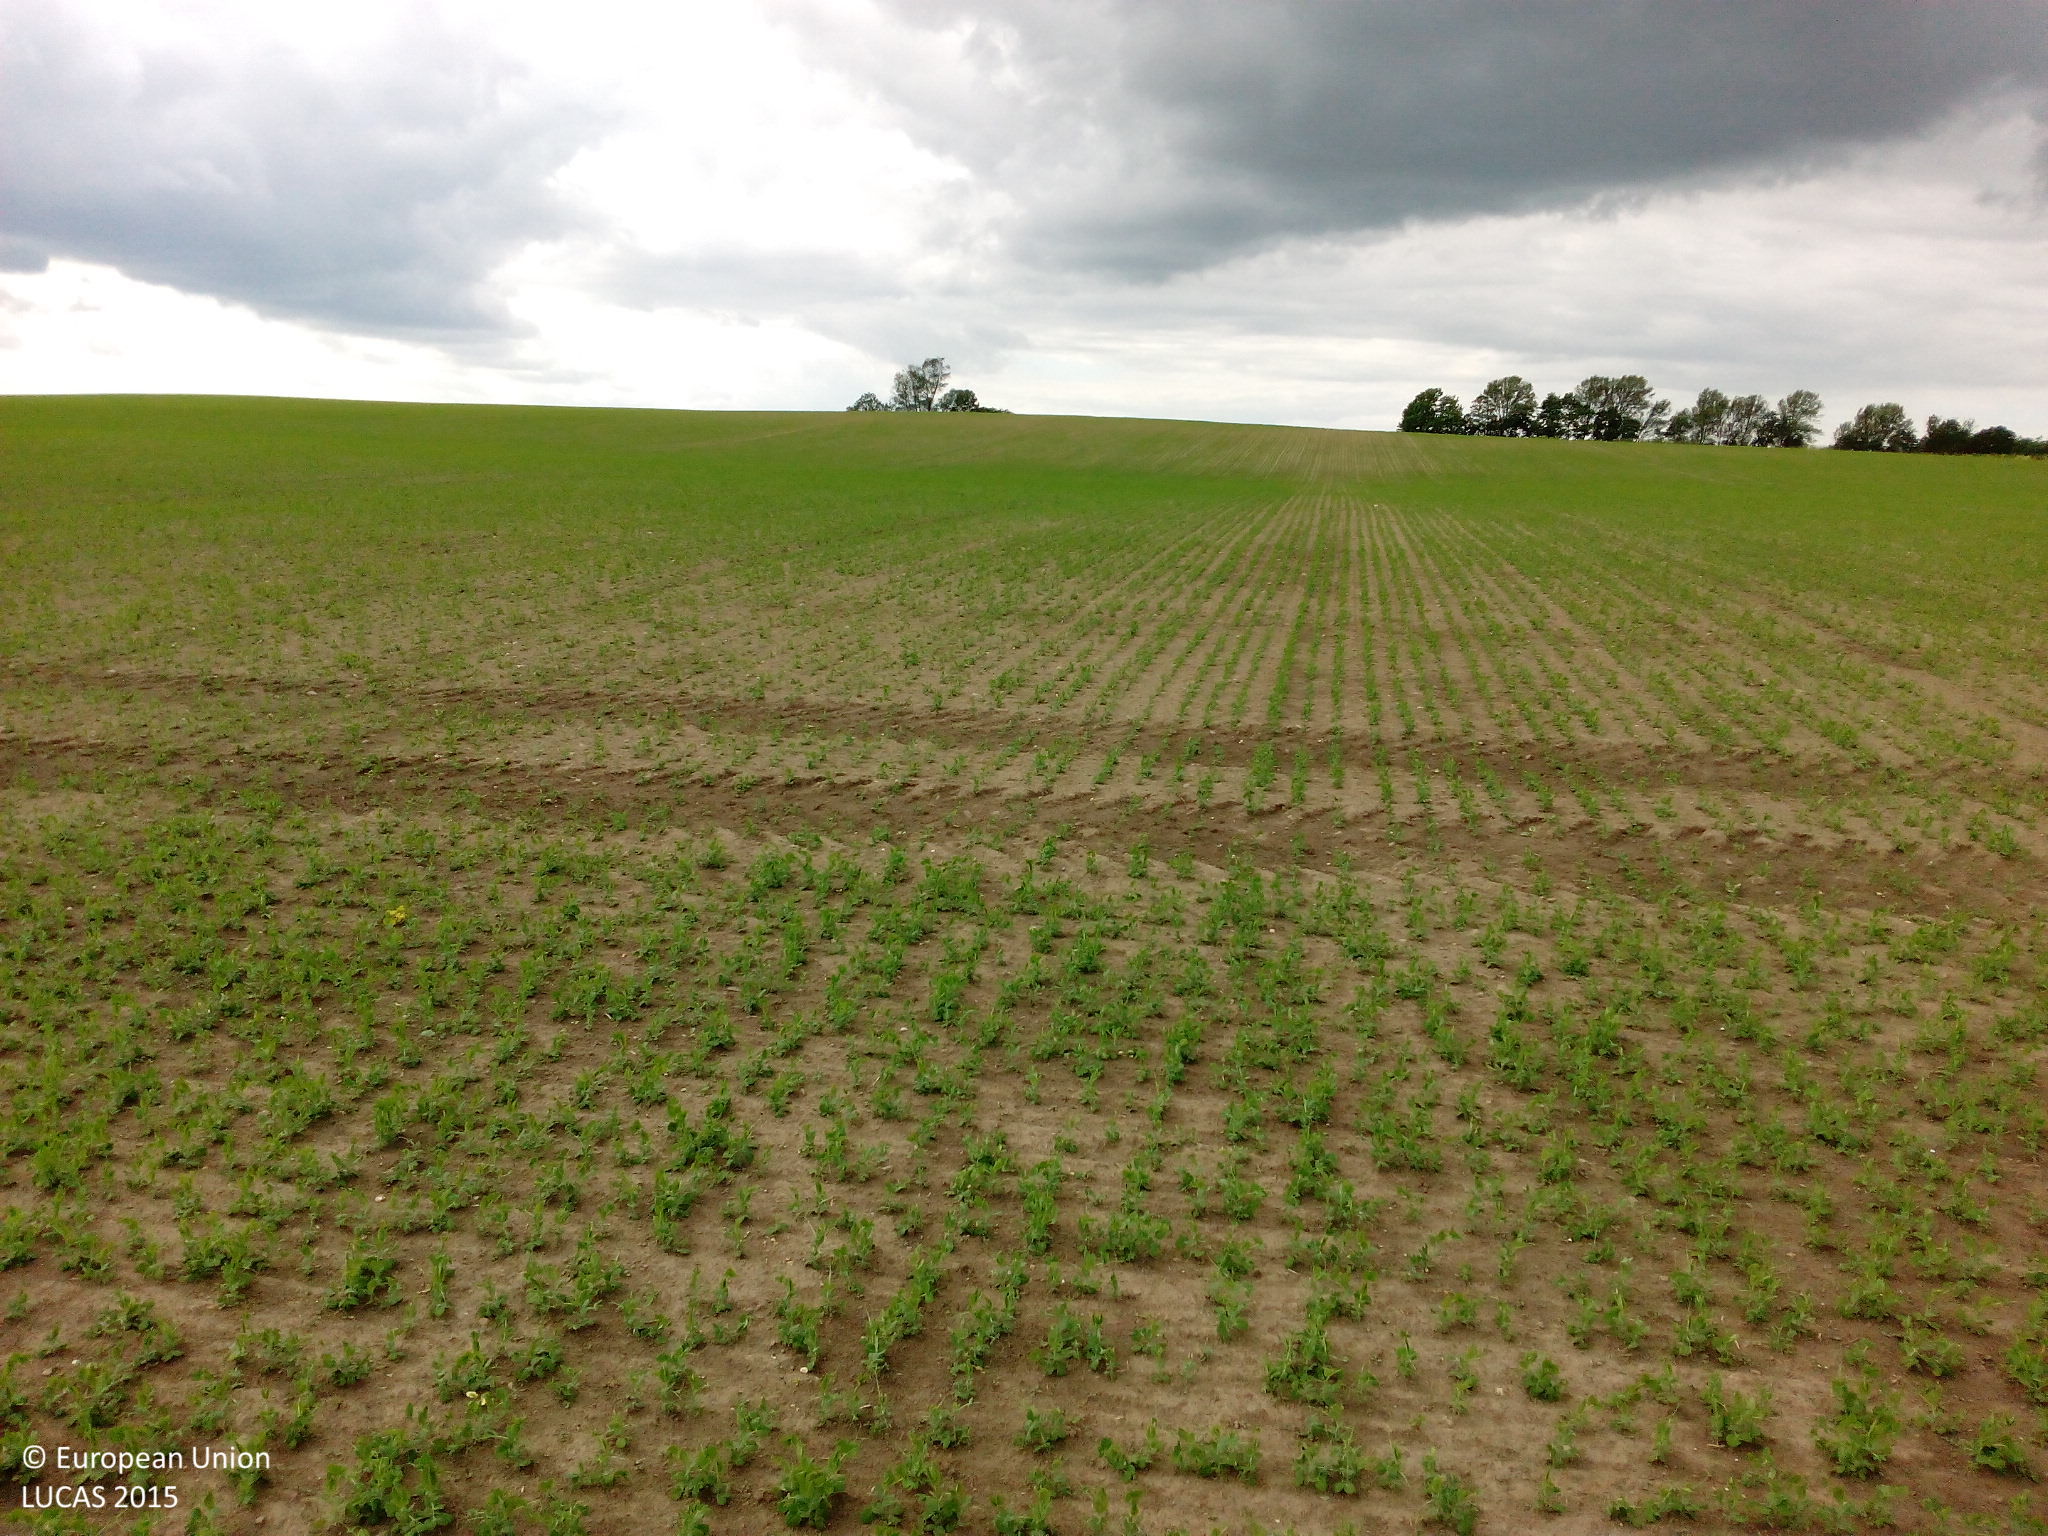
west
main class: Cropland
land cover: Dry pulses
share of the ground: > 75 %
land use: Agriculture (excluding fallow land and kitchen gardens)
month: July
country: DK
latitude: 55.2537
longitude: 12.0909
